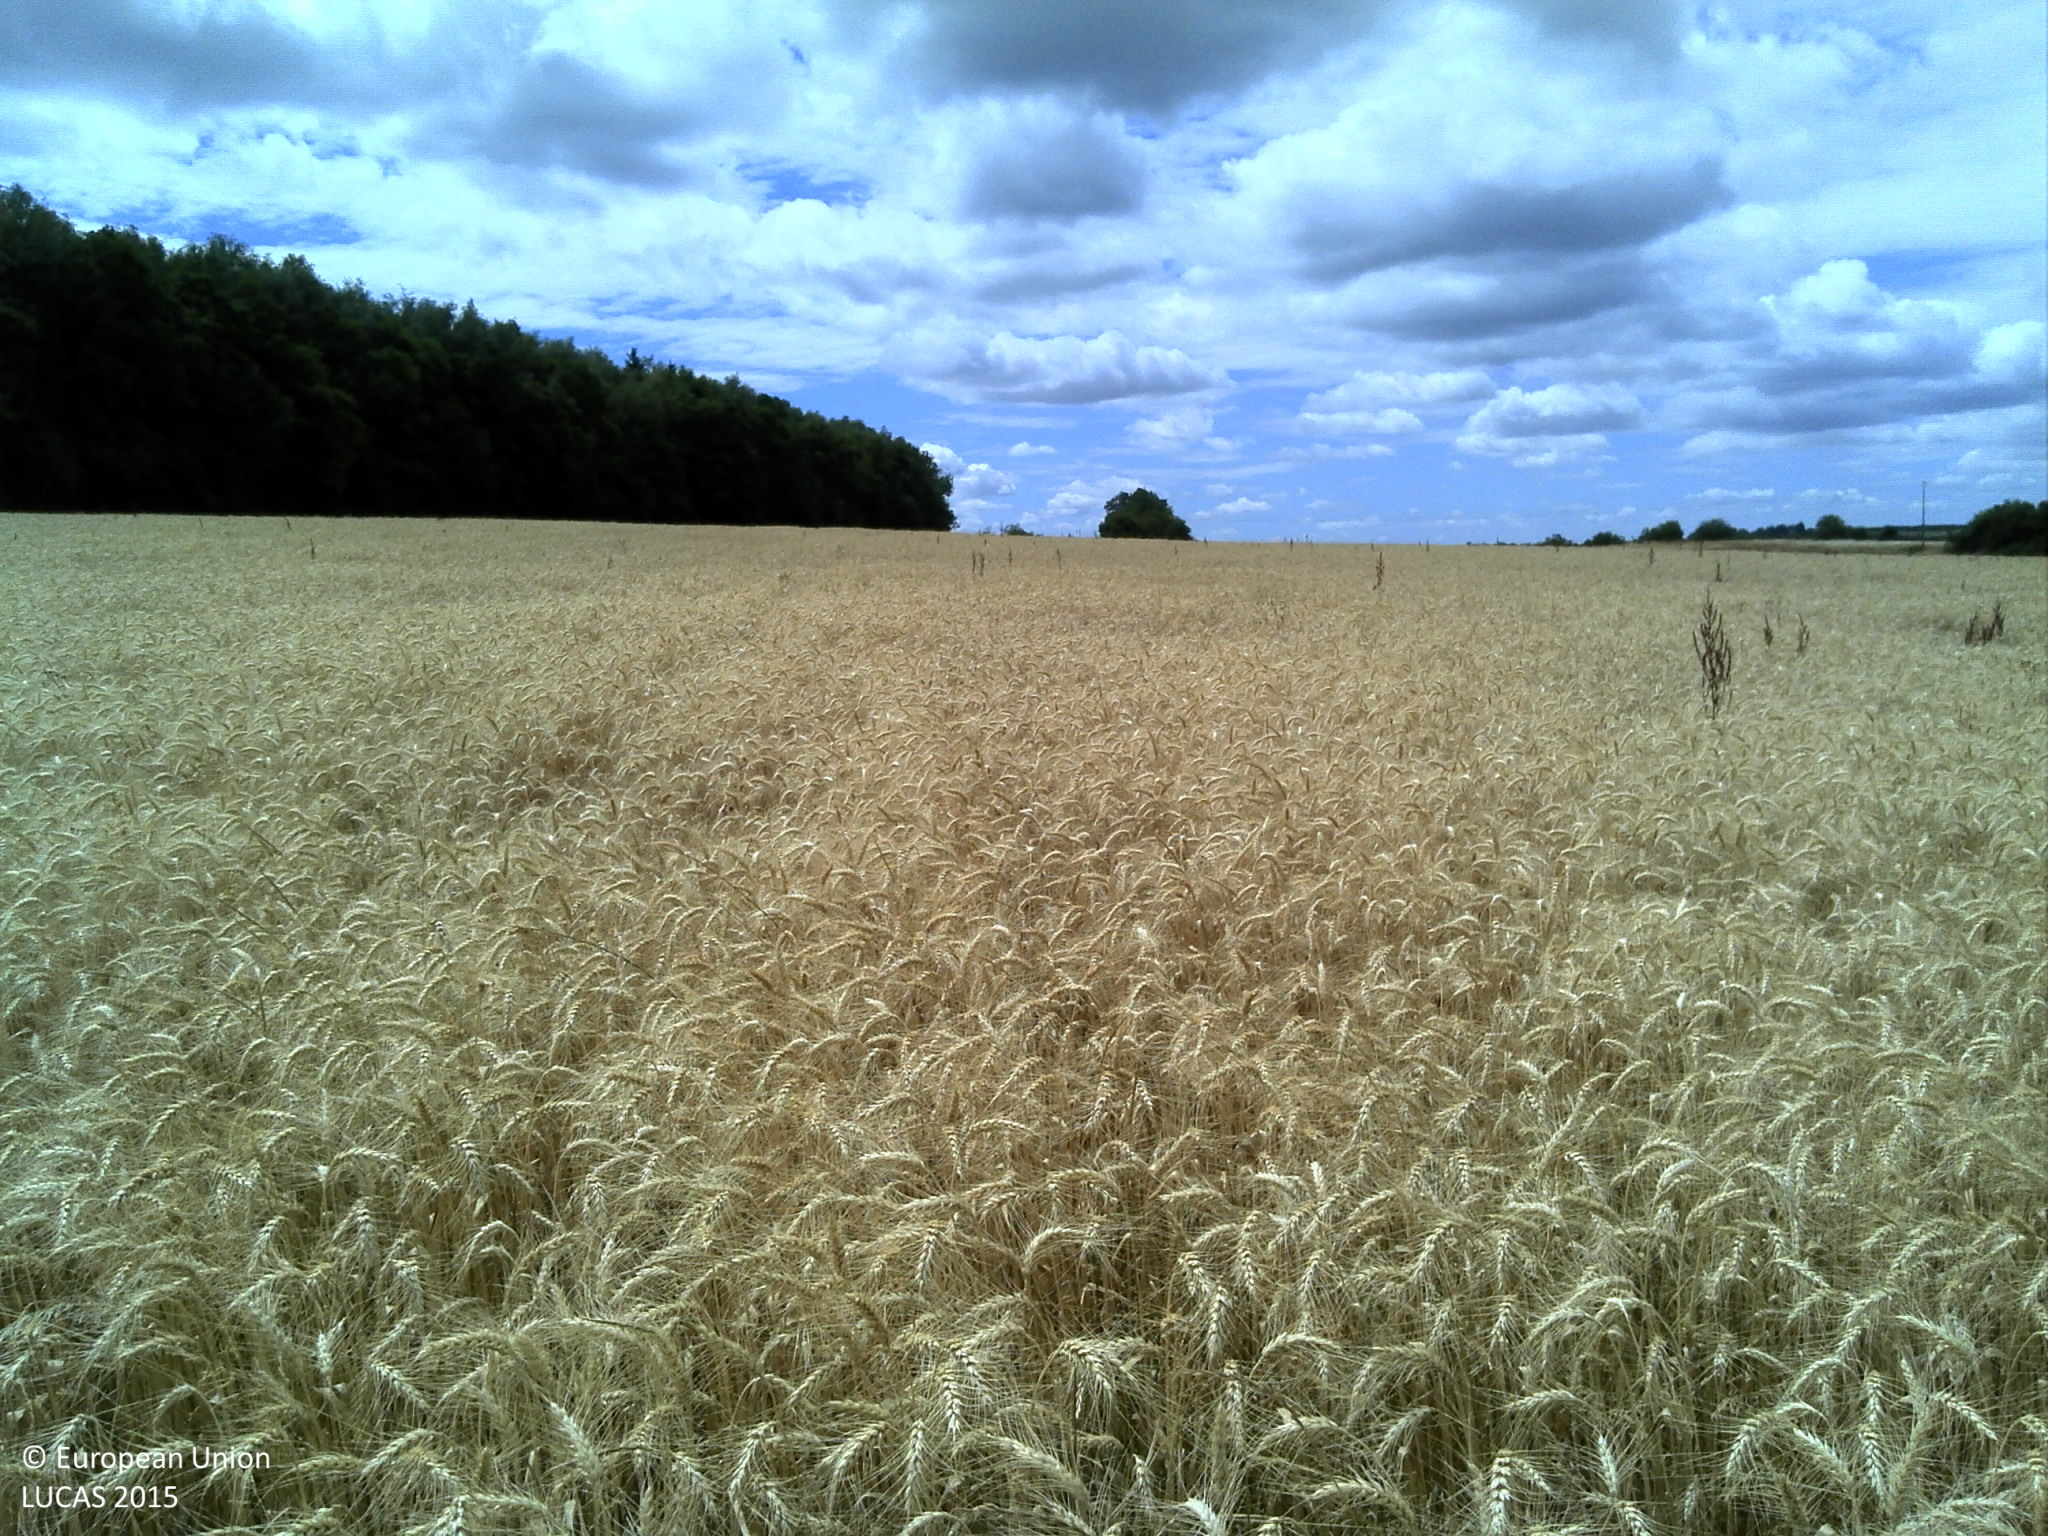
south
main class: Cropland
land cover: Durum wheat
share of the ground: > 75 %
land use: Agriculture (excluding fallow land and kitchen gardens)
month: July
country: FR
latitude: 48.1693
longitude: 6.0068
